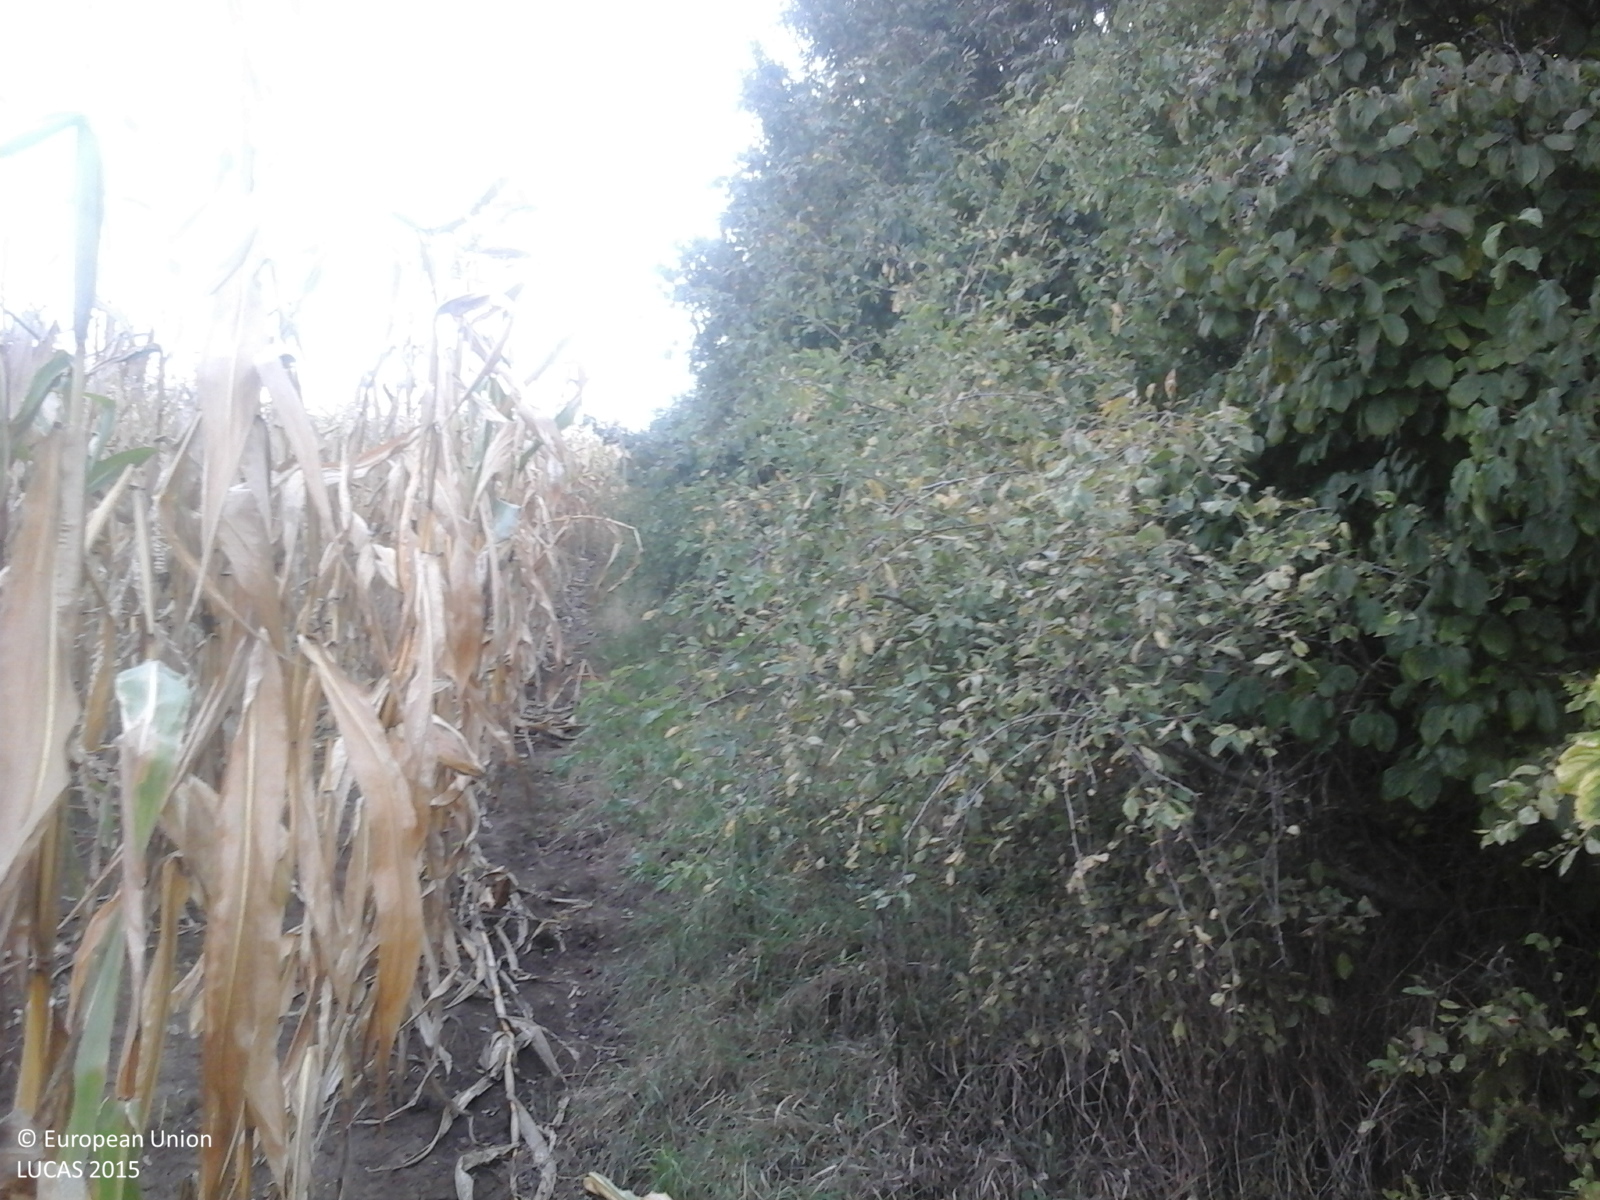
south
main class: Woodland
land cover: Broadleaved woodland
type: acidophilous oak and oak-birch forest
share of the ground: > 75 %
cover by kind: broadleaved forest trees 100 %
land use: Forestry
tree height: > 5 m
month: September
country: RO
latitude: 46.8052
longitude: 24.0617
